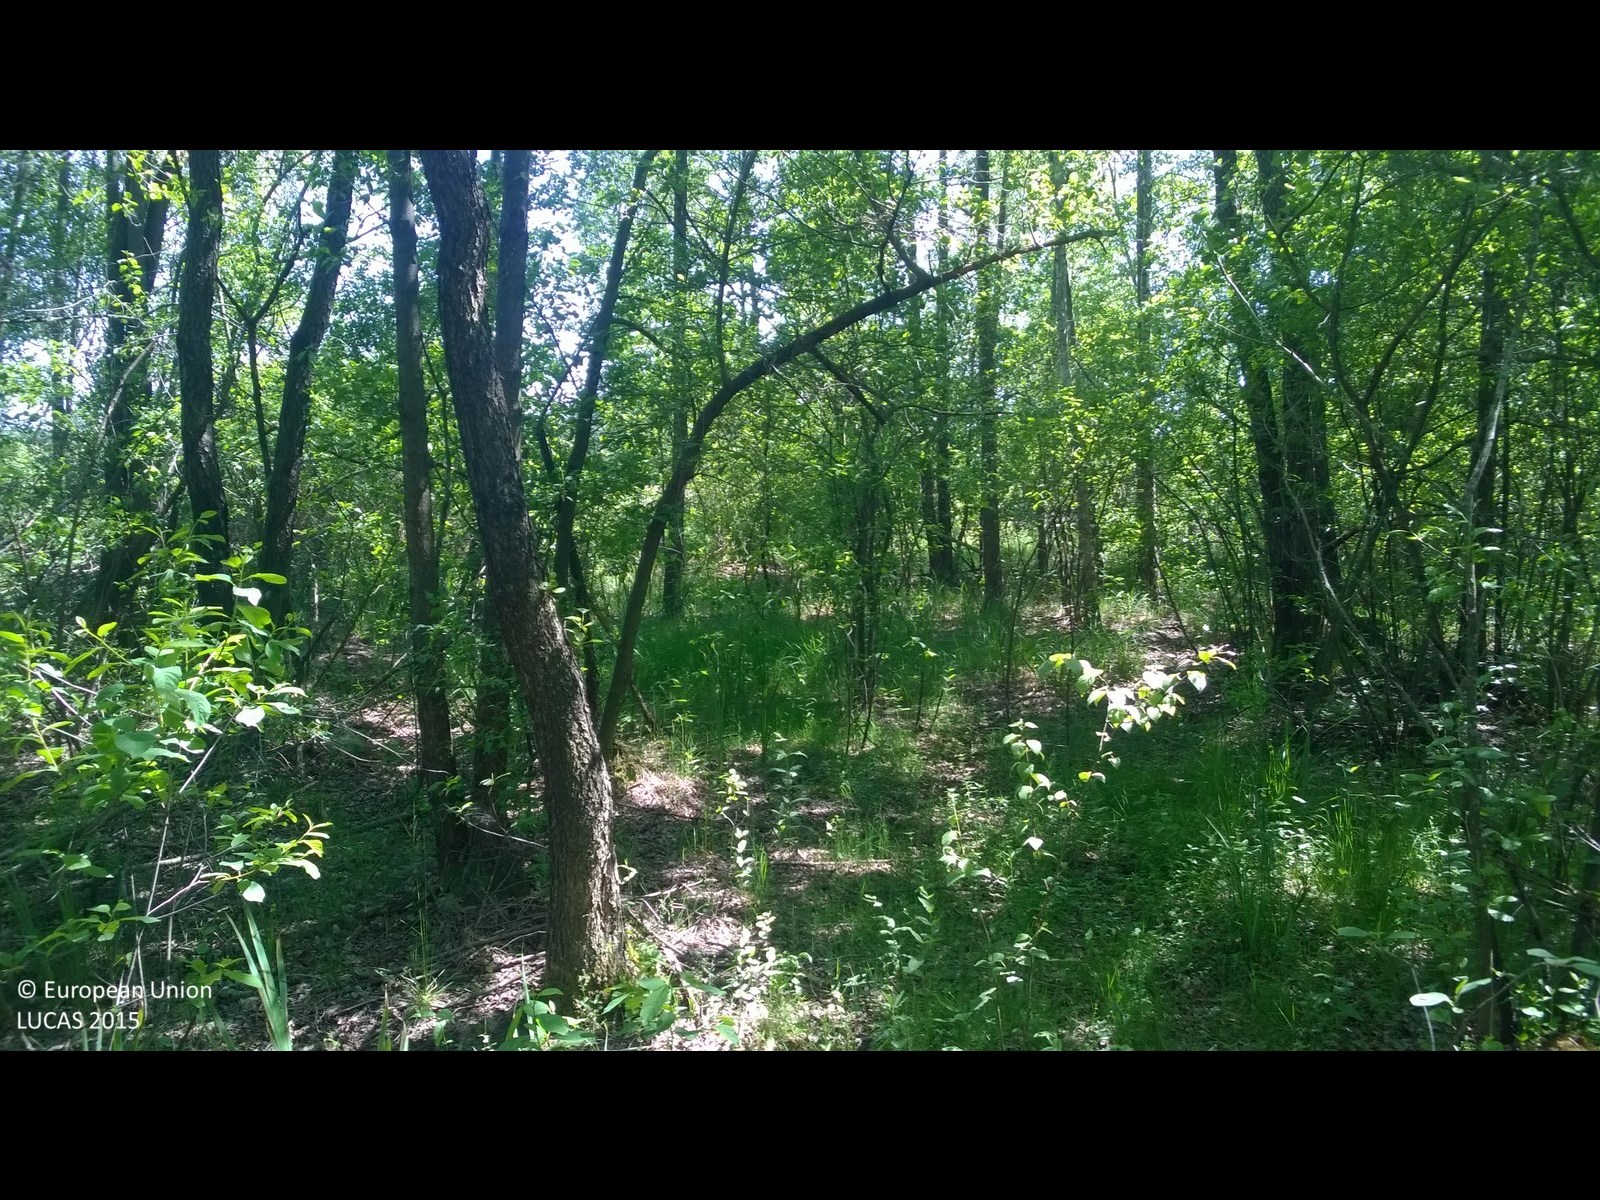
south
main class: Woodland
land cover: Broadleaved woodland
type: mesophytic deciduous forest
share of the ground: > 75 %
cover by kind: broadleaved forest trees 80 %, shrubs 15 %, herbaceous plants 5 %
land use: Forestry
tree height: > 5 m
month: June
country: PL
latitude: 53.0038
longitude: 23.3590
